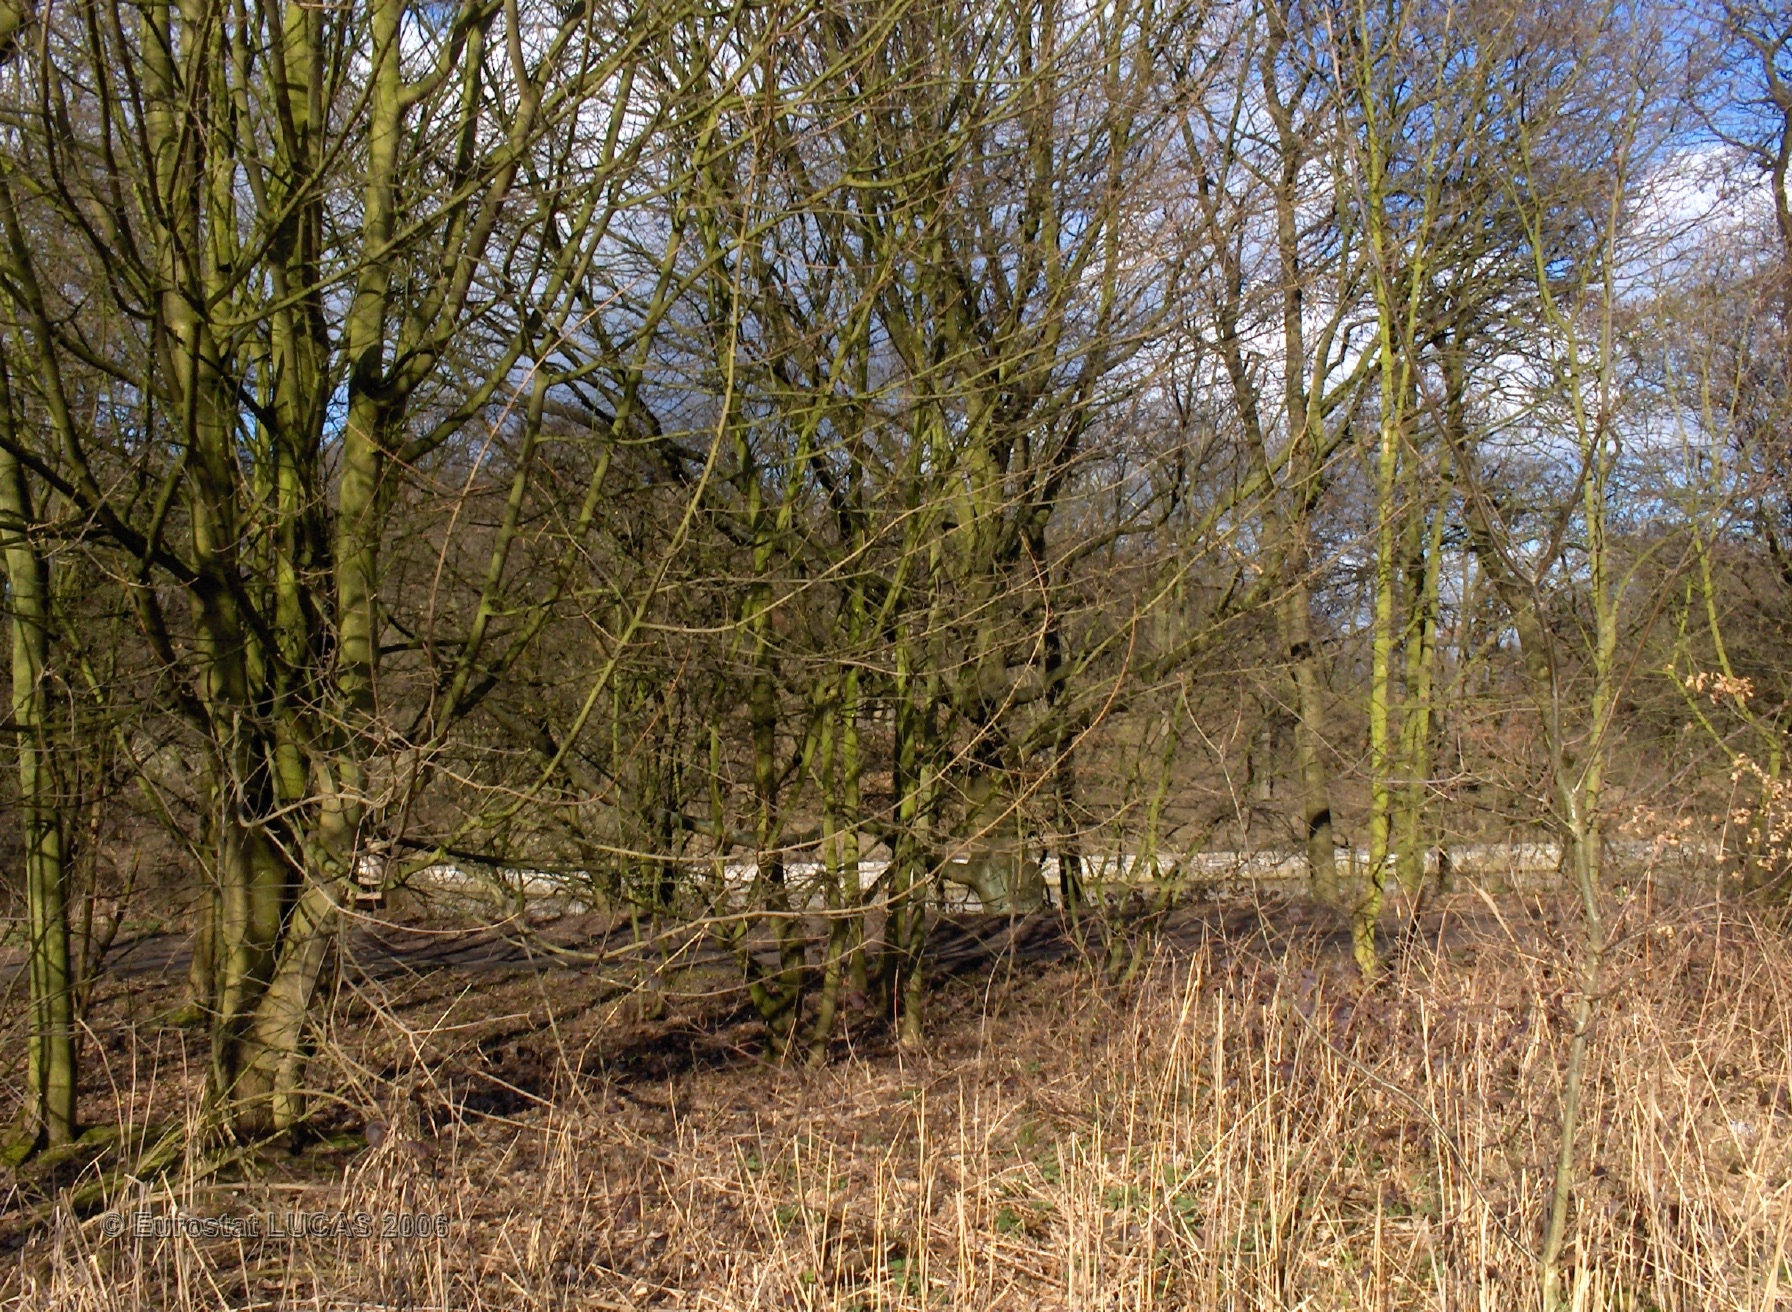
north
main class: Grassland
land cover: Grassland with sparse tree/shrub cover
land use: Agriculture (excluding fallow land and kitchen gardens)
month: April
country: BE
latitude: 51.1657
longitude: 4.4325
